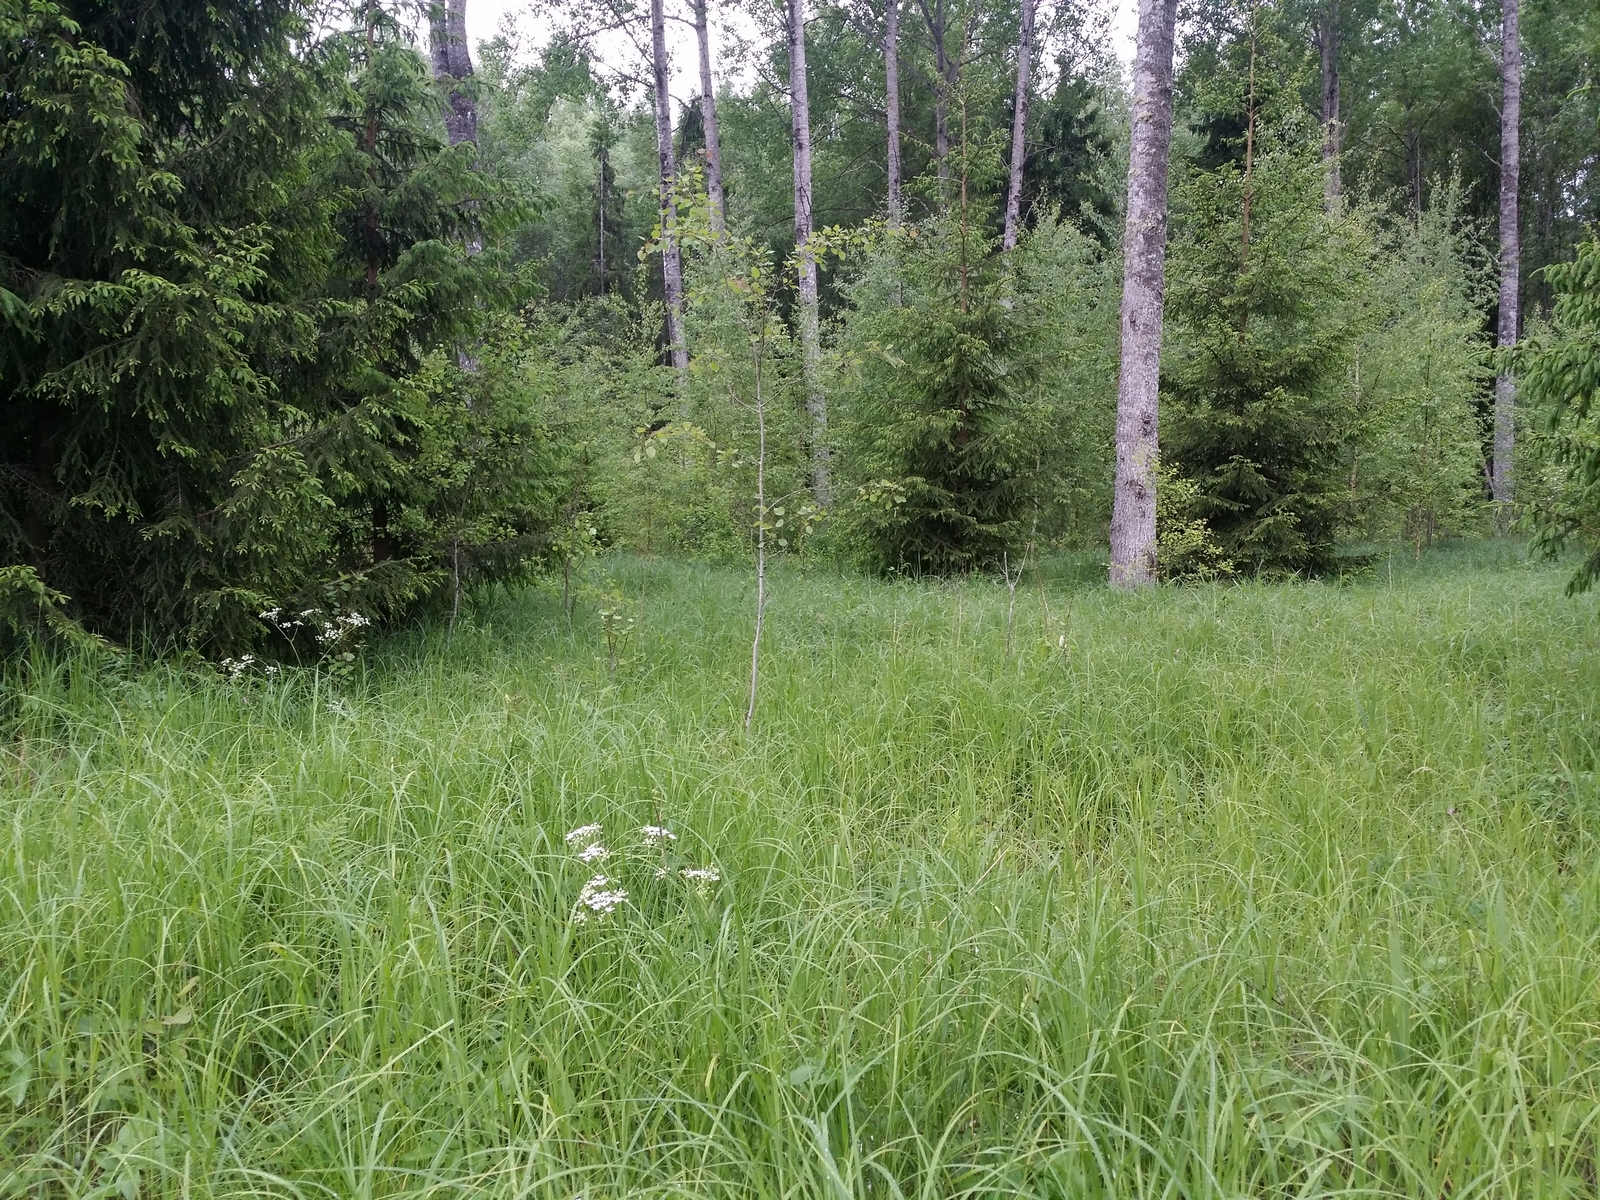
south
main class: Grassland
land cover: Spontaneously vegetated surfaces
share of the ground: > 75 %
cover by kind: herbaceous plants 95 %, shrubs 5 %
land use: Forestry
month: June
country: LV
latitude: 57.5175
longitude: 26.5211
